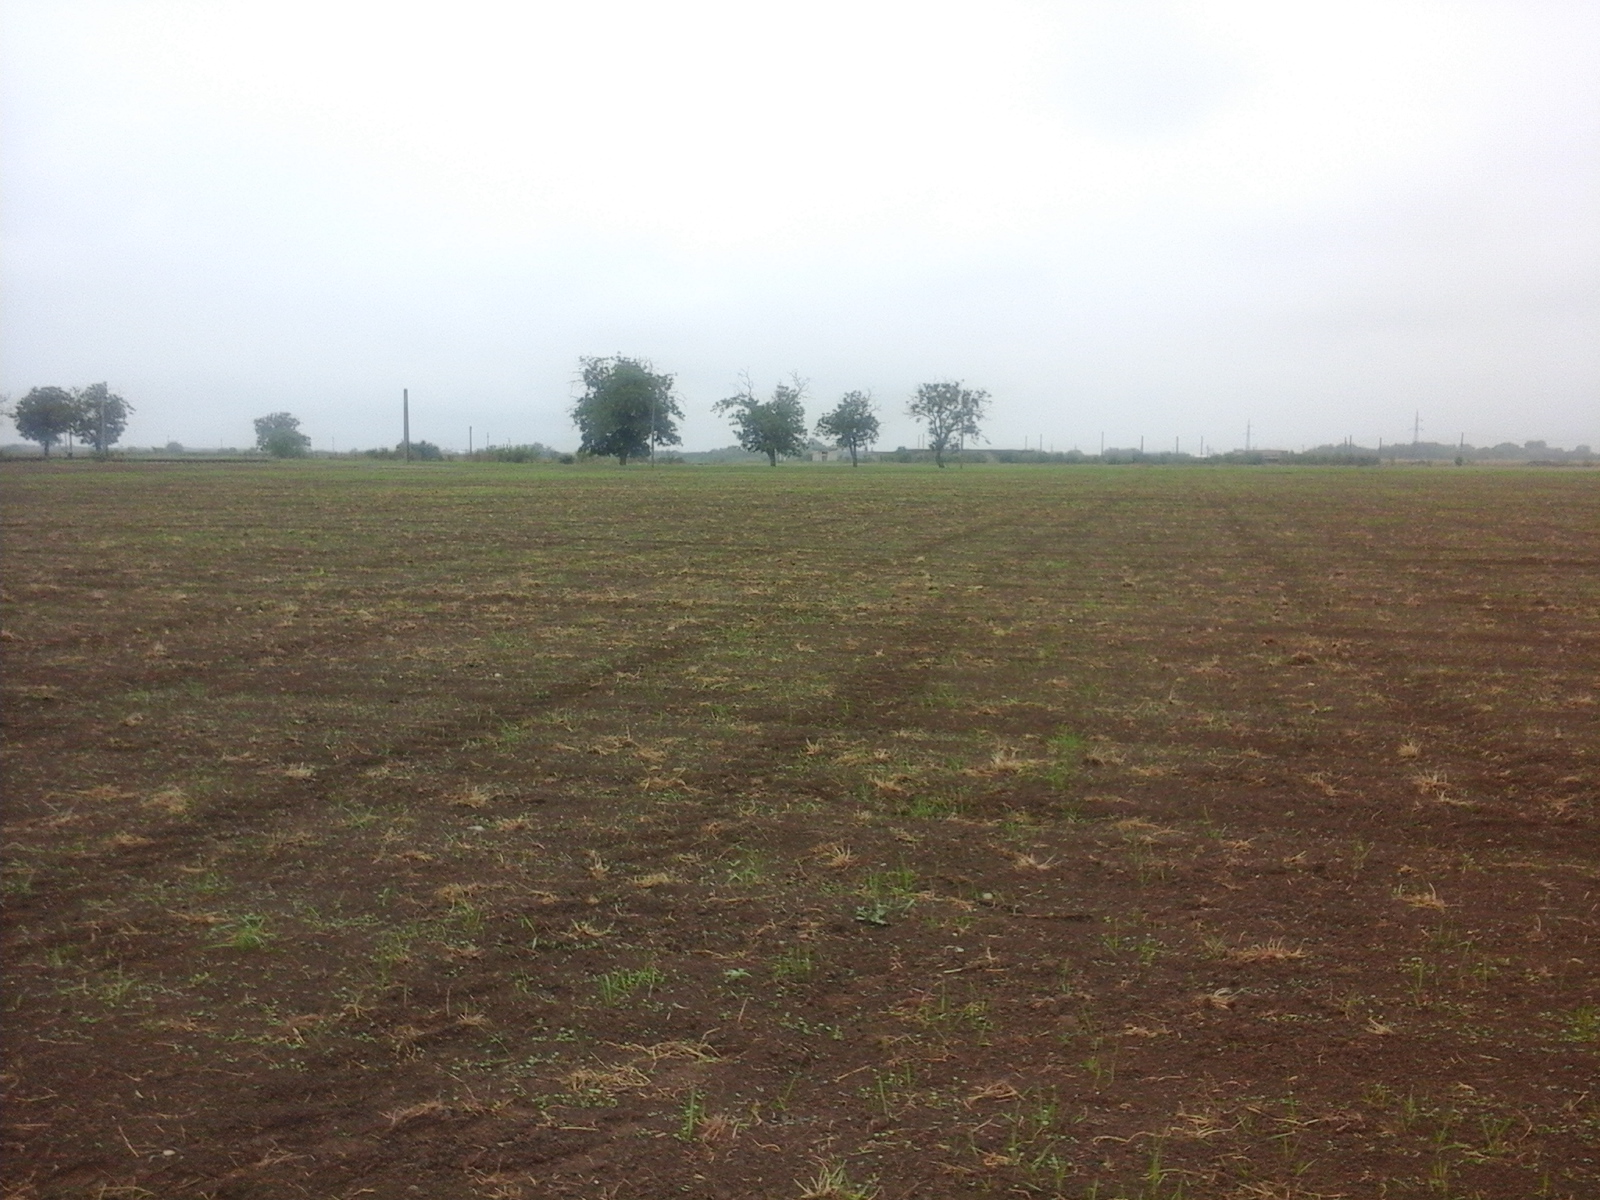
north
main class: Cropland
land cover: Dry pulses
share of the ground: < 10 %
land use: Agriculture (excluding fallow land and kitchen gardens)
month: September
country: RO
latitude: 47.0746
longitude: 21.8317
